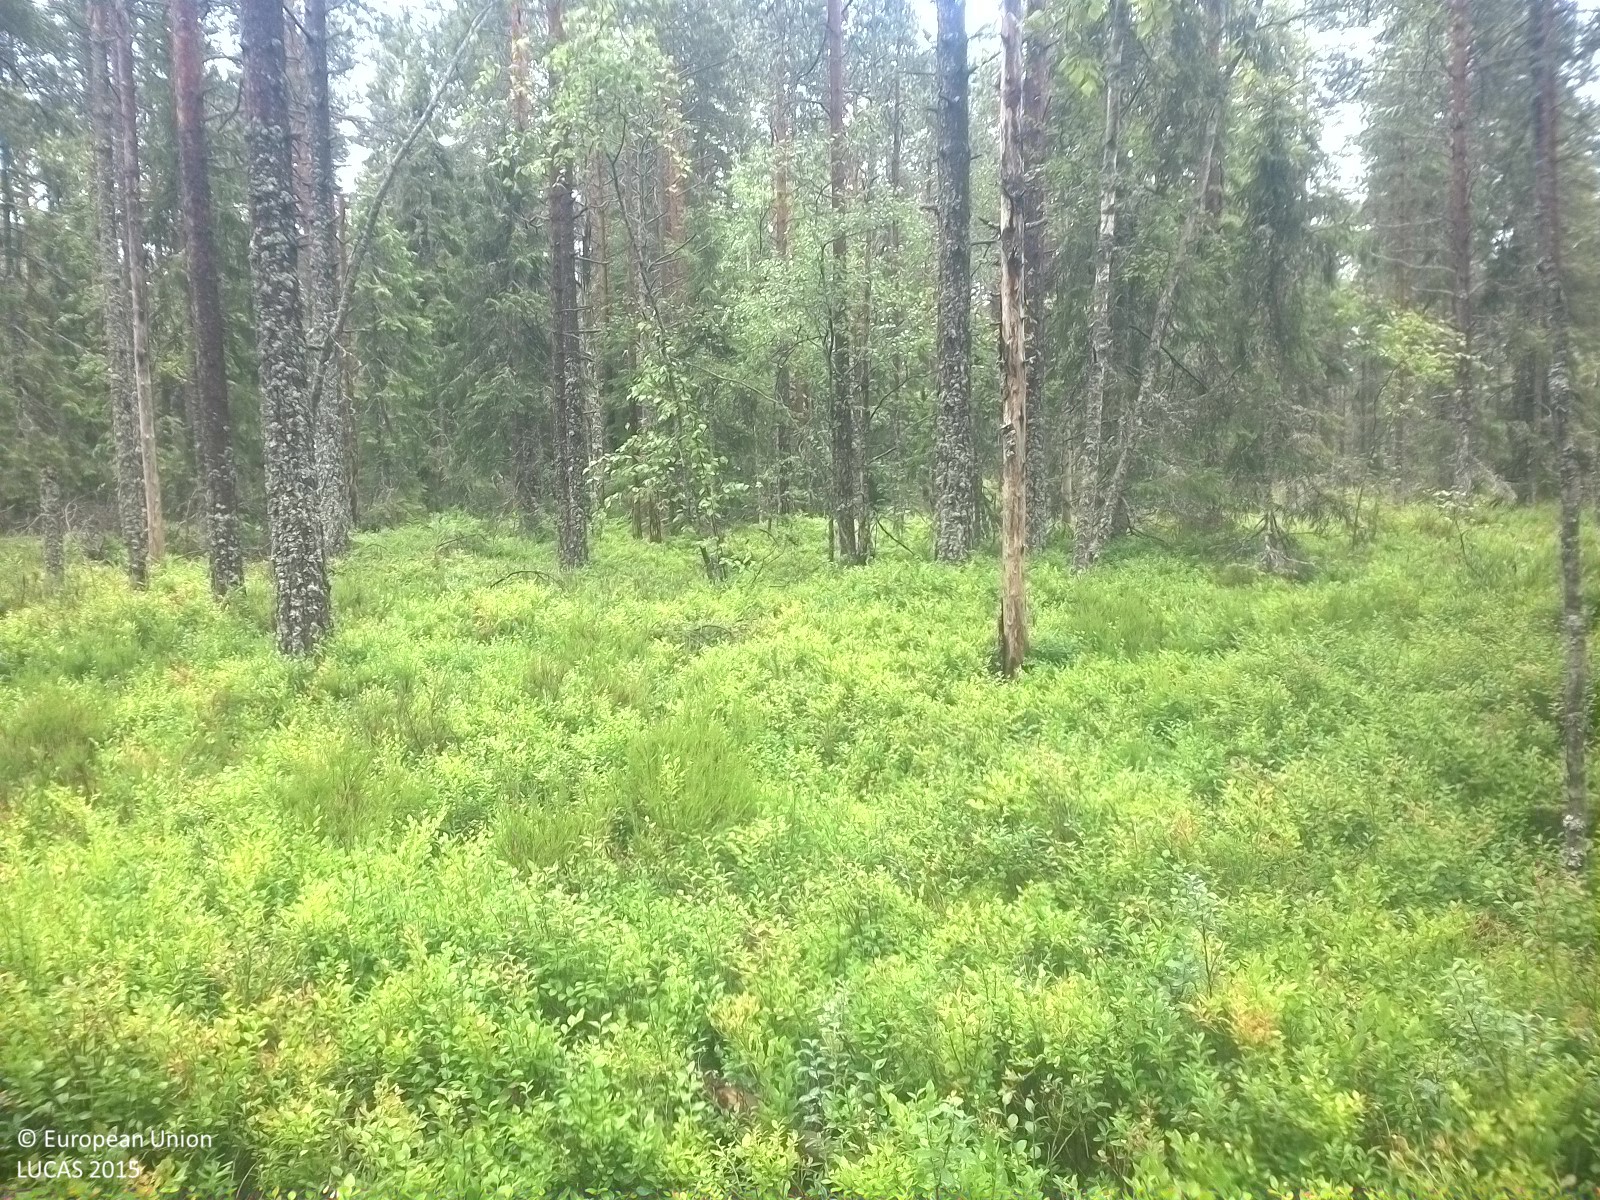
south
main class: Woodland
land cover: Pine dominated mixed woodland
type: boreal forest
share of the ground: 25 - 50 %
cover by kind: herbaceous plants 40 %, coniferous forest trees 25 %, shrubs 15 %, broadleaved forest trees 10 %, lichens and mosses 10 %
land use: Forestry
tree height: > 5 m
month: July
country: SE
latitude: 58.8246
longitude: 15.1367
